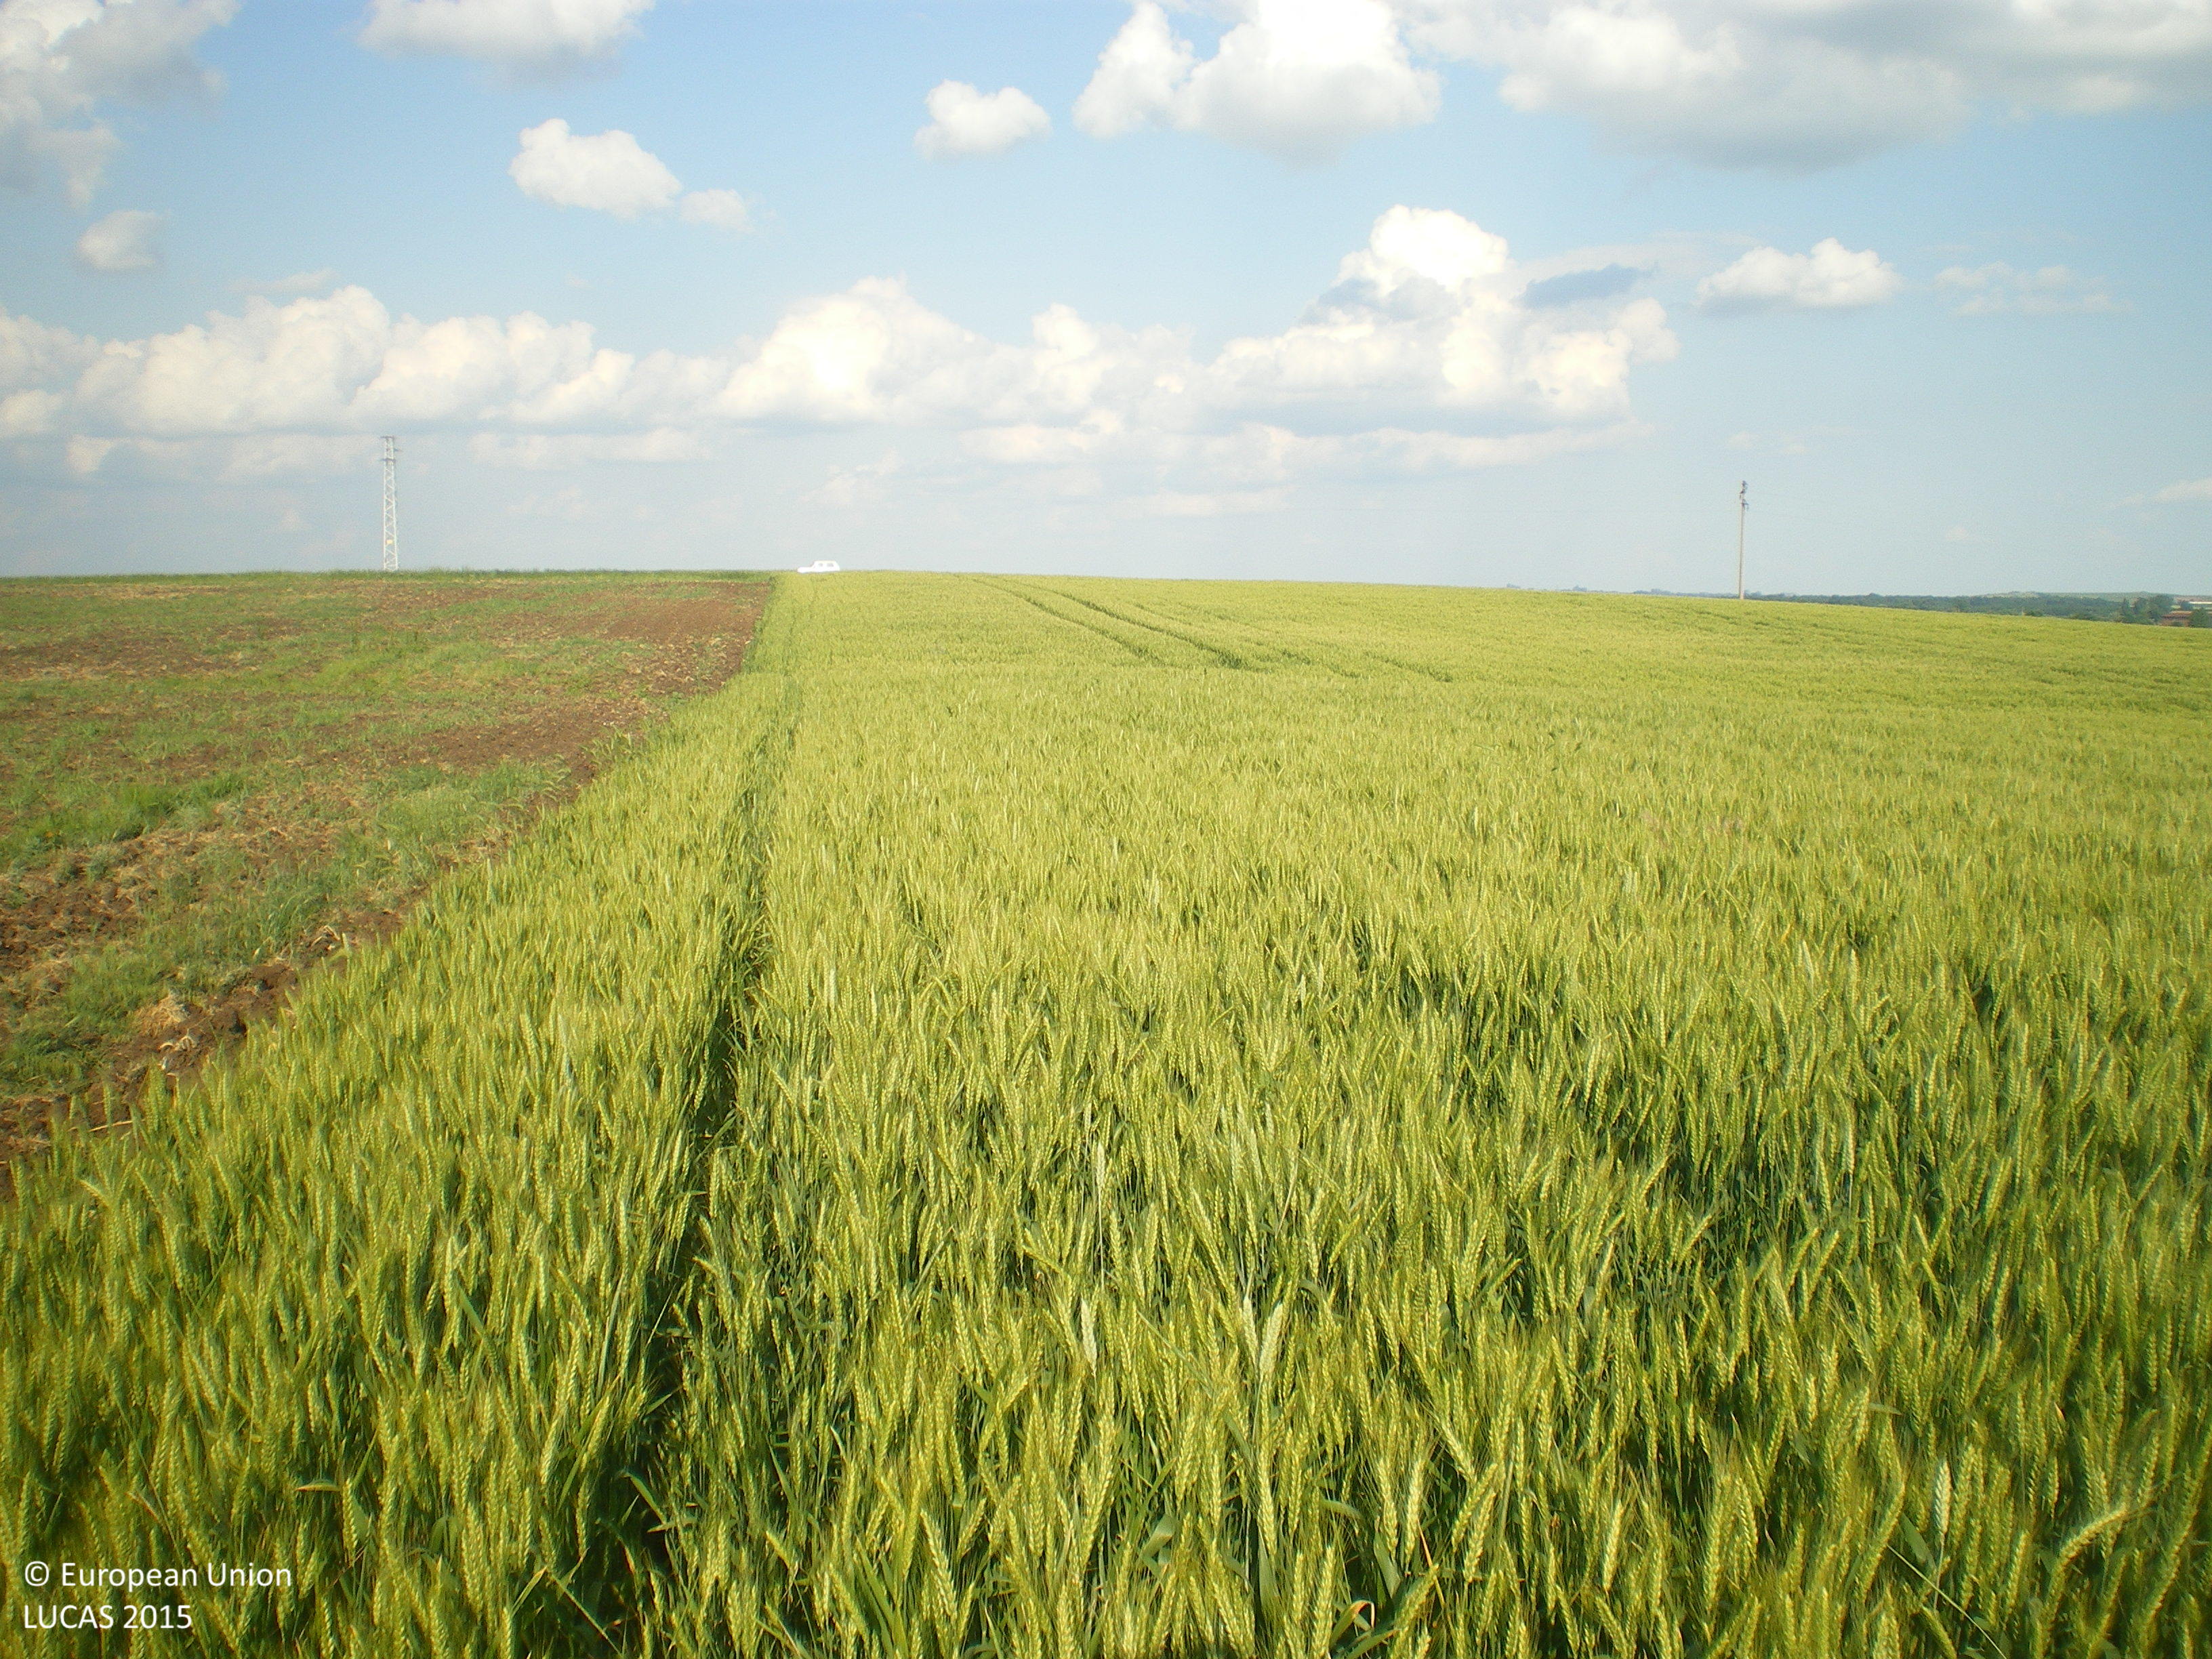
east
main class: Cropland
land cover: Durum wheat
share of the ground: > 75 %
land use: Agriculture (excluding fallow land and kitchen gardens)
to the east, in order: Durum wheat; Tracks; Electric lines; Durum wheat
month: May
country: BG
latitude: 42.2300
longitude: 25.2190
